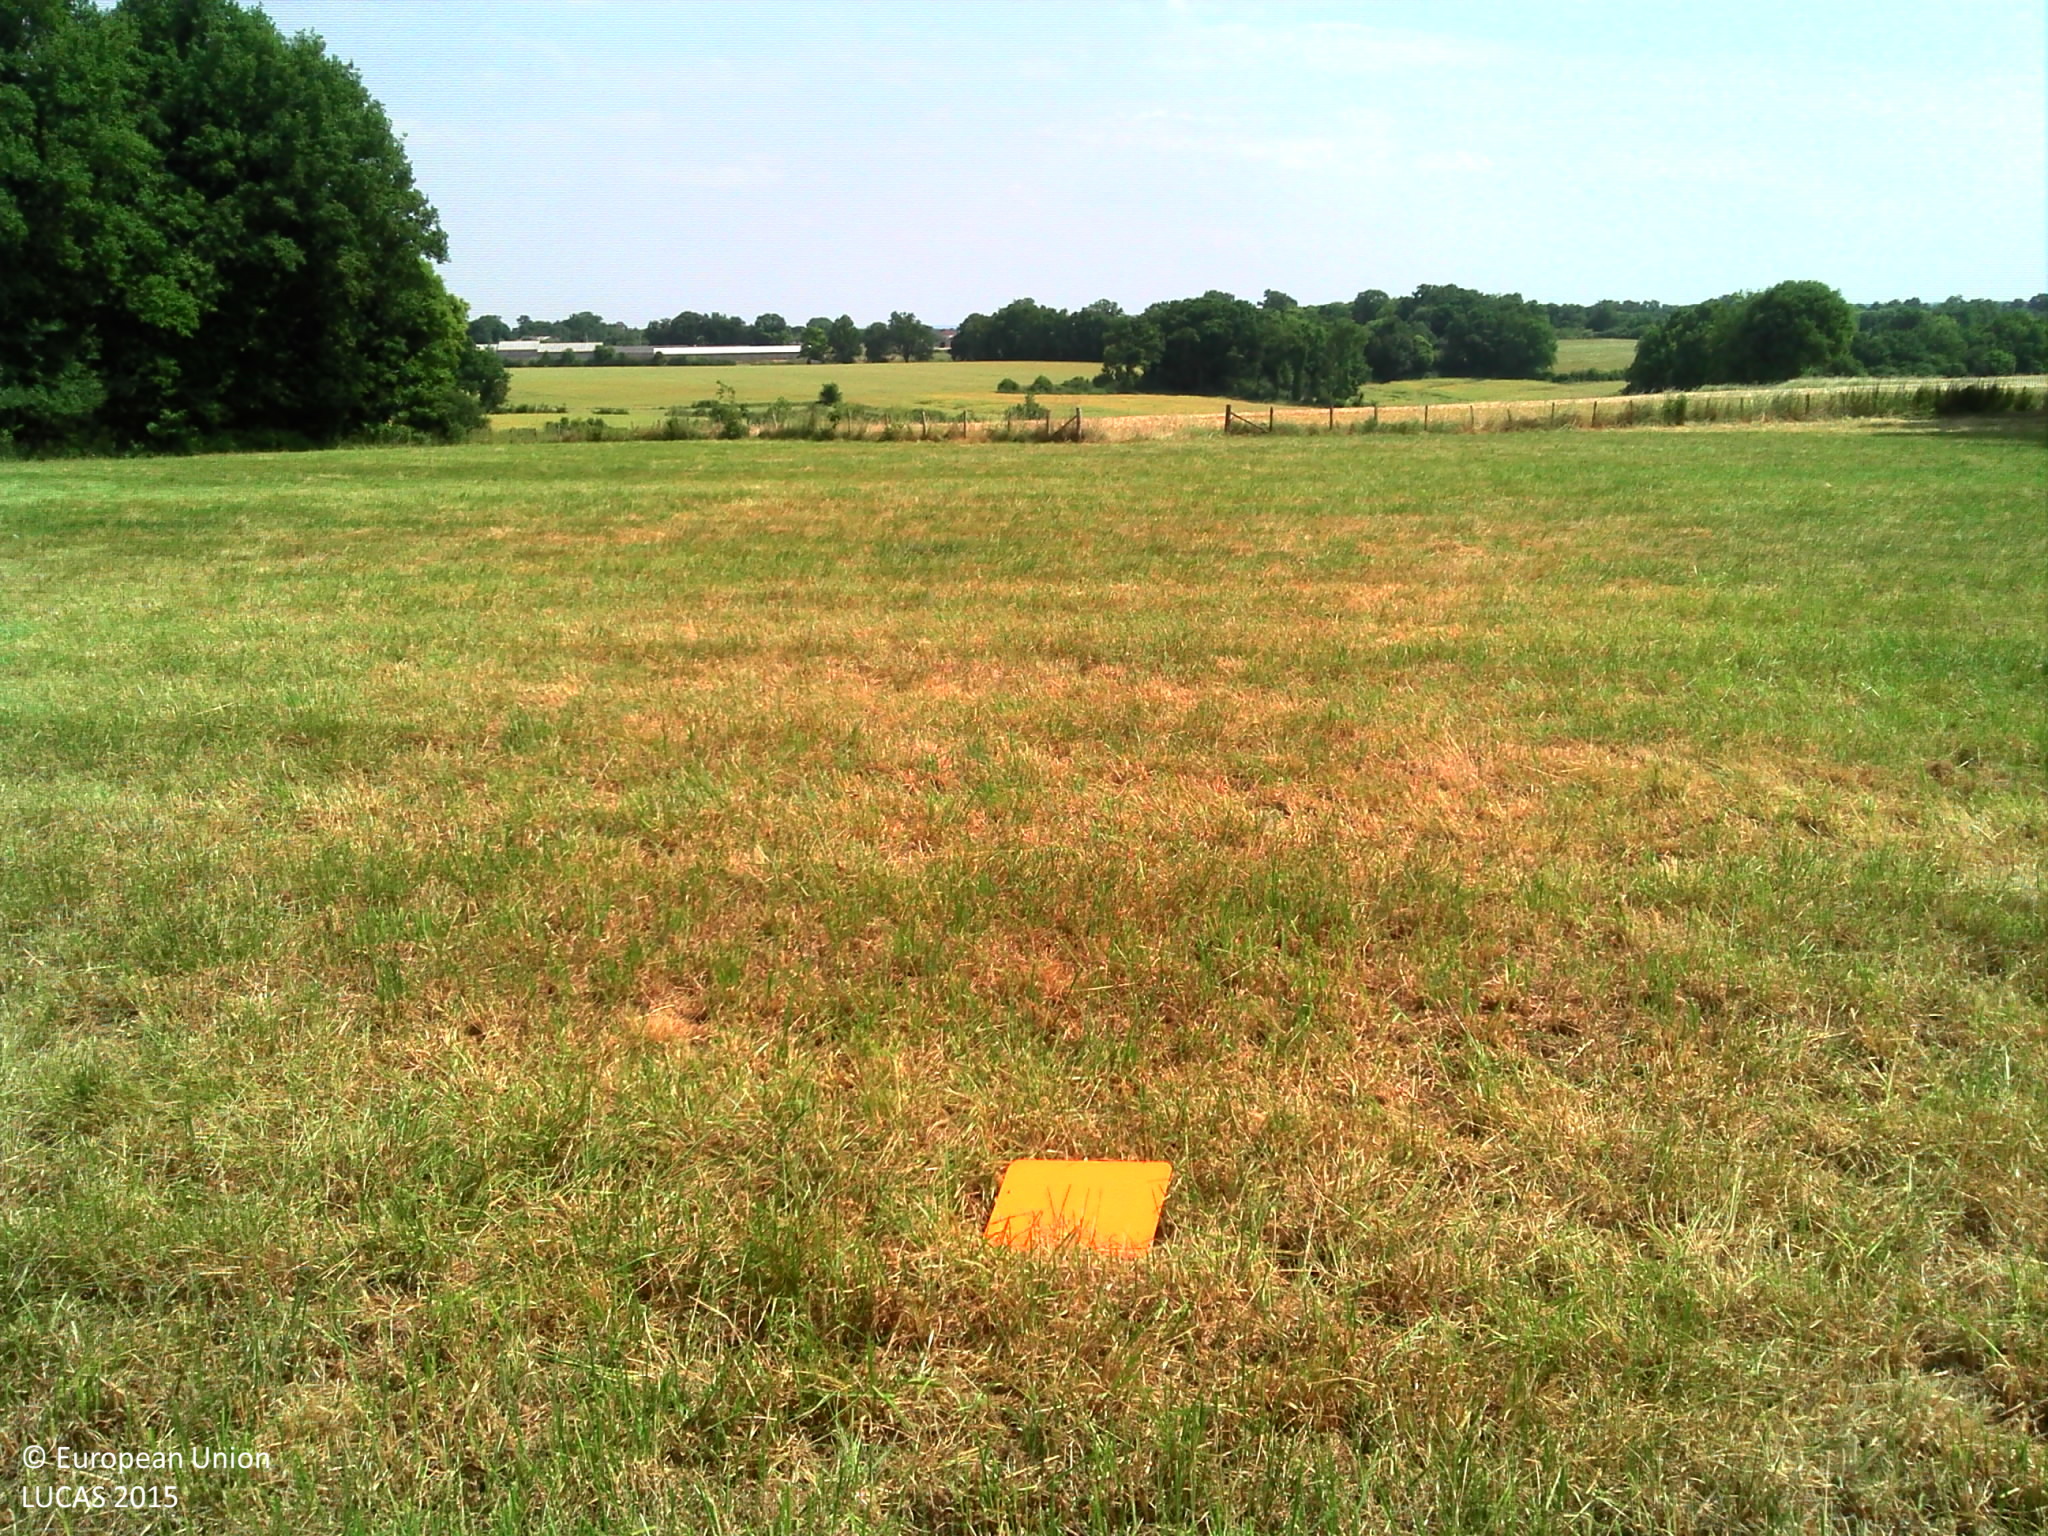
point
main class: Grassland
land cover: Grassland without tree/shrub cover
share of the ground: > 75 %
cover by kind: herbaceous plants 100 %
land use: Agriculture (excluding fallow land and kitchen gardens)
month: June
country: FR
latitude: 45.9344
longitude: 0.3756
